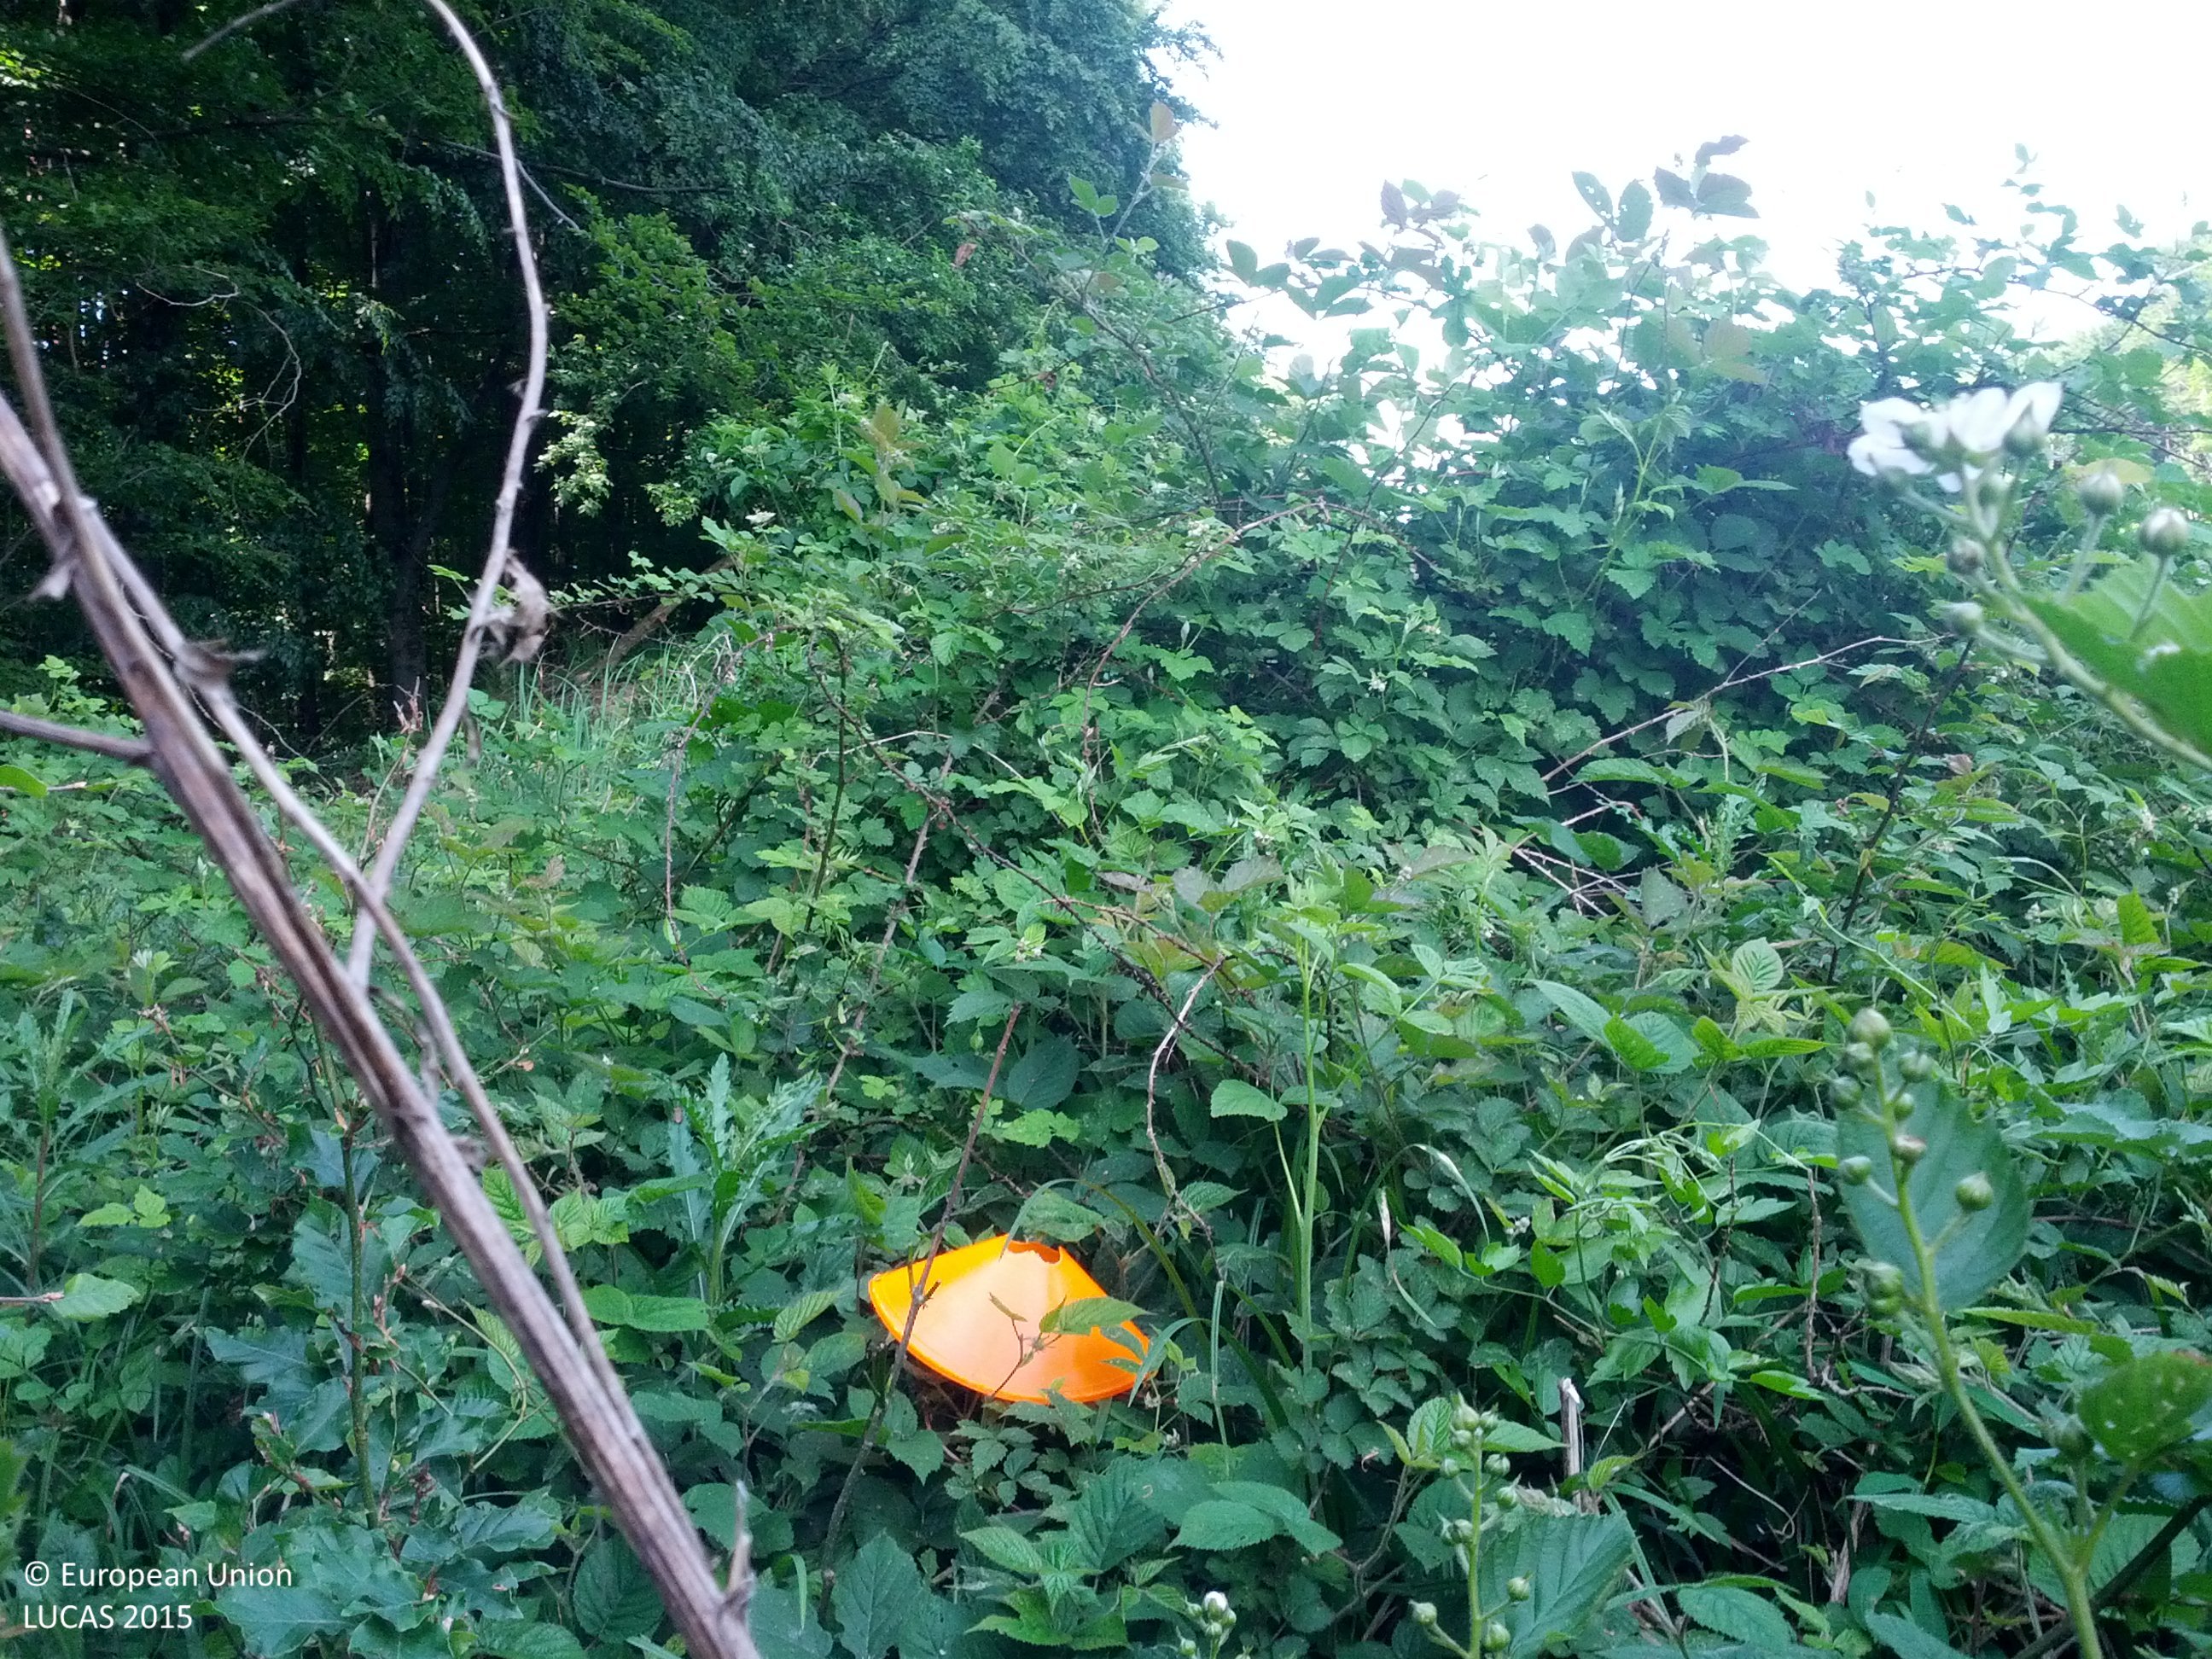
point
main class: Shrubland
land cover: Shrubland without tree cover
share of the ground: > 75 %
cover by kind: shrubs 80 %, herbaceous plants 20 %
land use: Electricity, gas and thermal power distribution
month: May
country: AT
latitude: 48.2468
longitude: 16.2127
